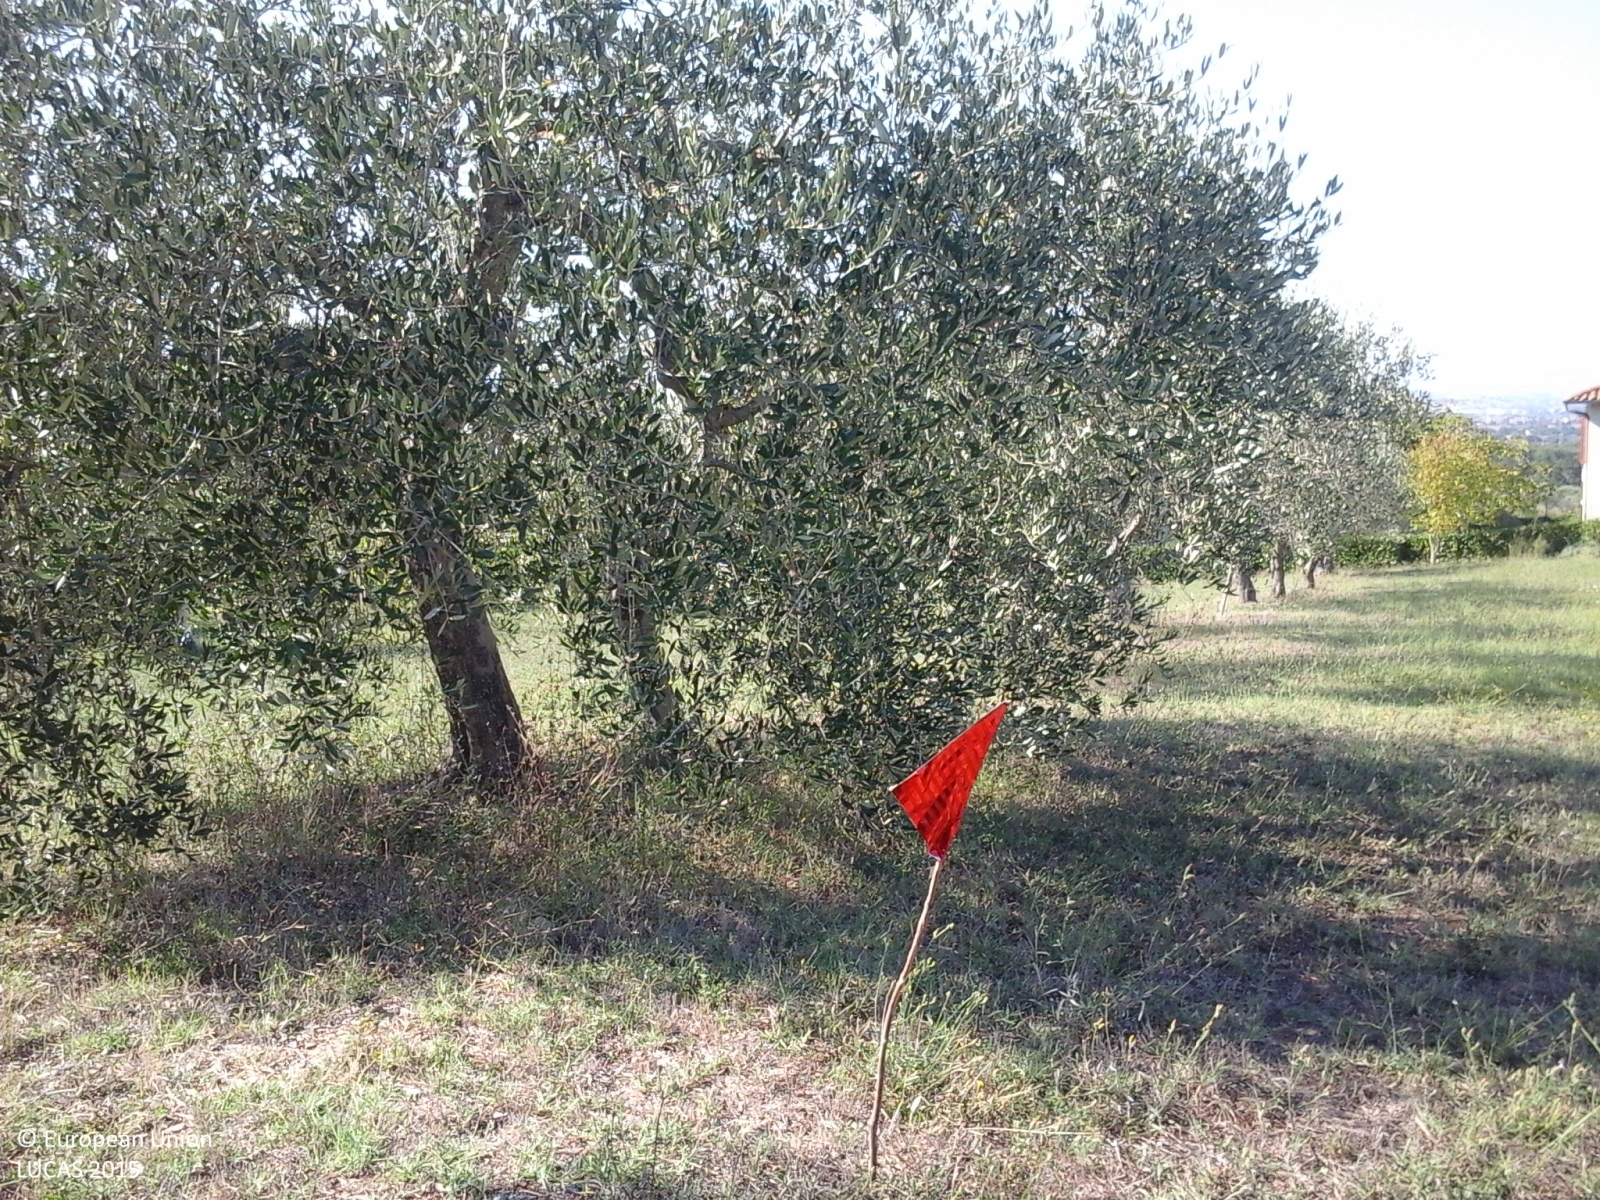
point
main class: Cropland
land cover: Olive groves
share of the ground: 10 - 25 %
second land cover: Grassland without tree/shrub cover
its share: > 75 %
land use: Agriculture (excluding fallow land and kitchen gardens)
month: August
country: IT
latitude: 42.8615
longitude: 12.3550
